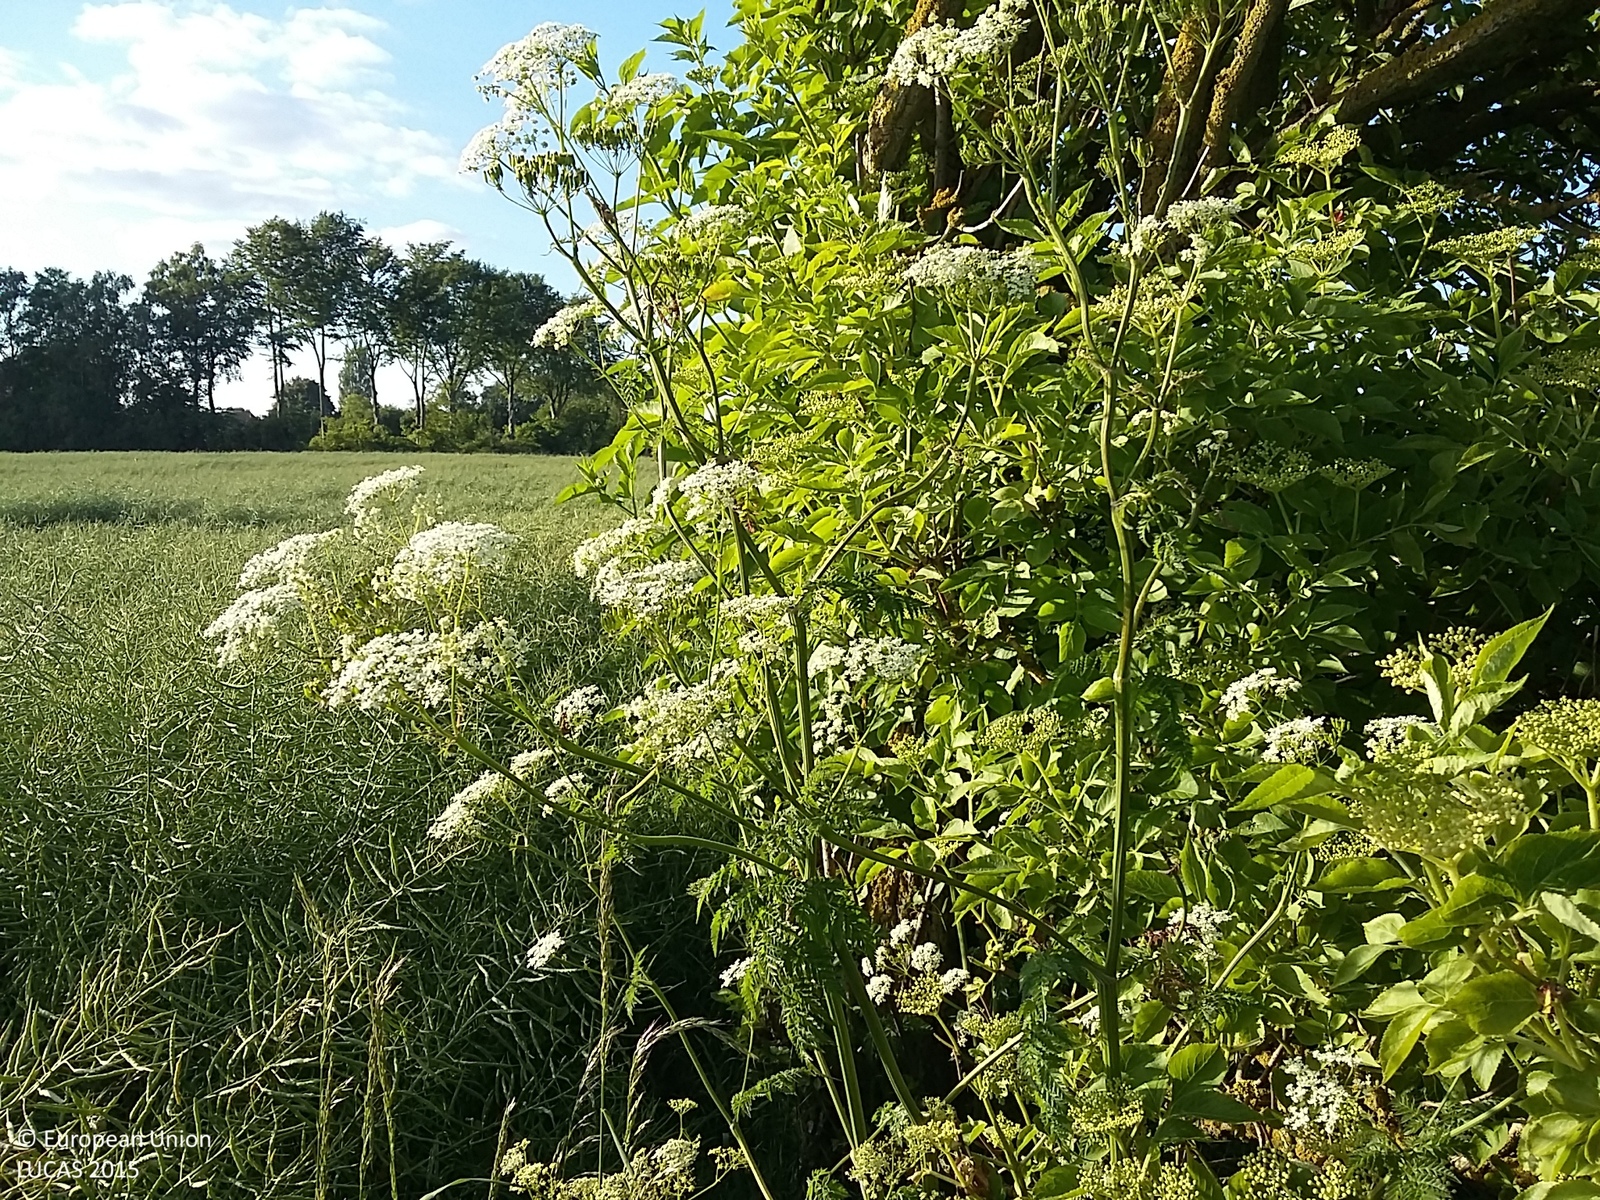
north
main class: Cropland
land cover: Rape and turnip rape
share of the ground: > 75 %
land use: Agriculture (excluding fallow land and kitchen gardens)
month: June
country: DK
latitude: 55.2150
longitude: 10.7381
